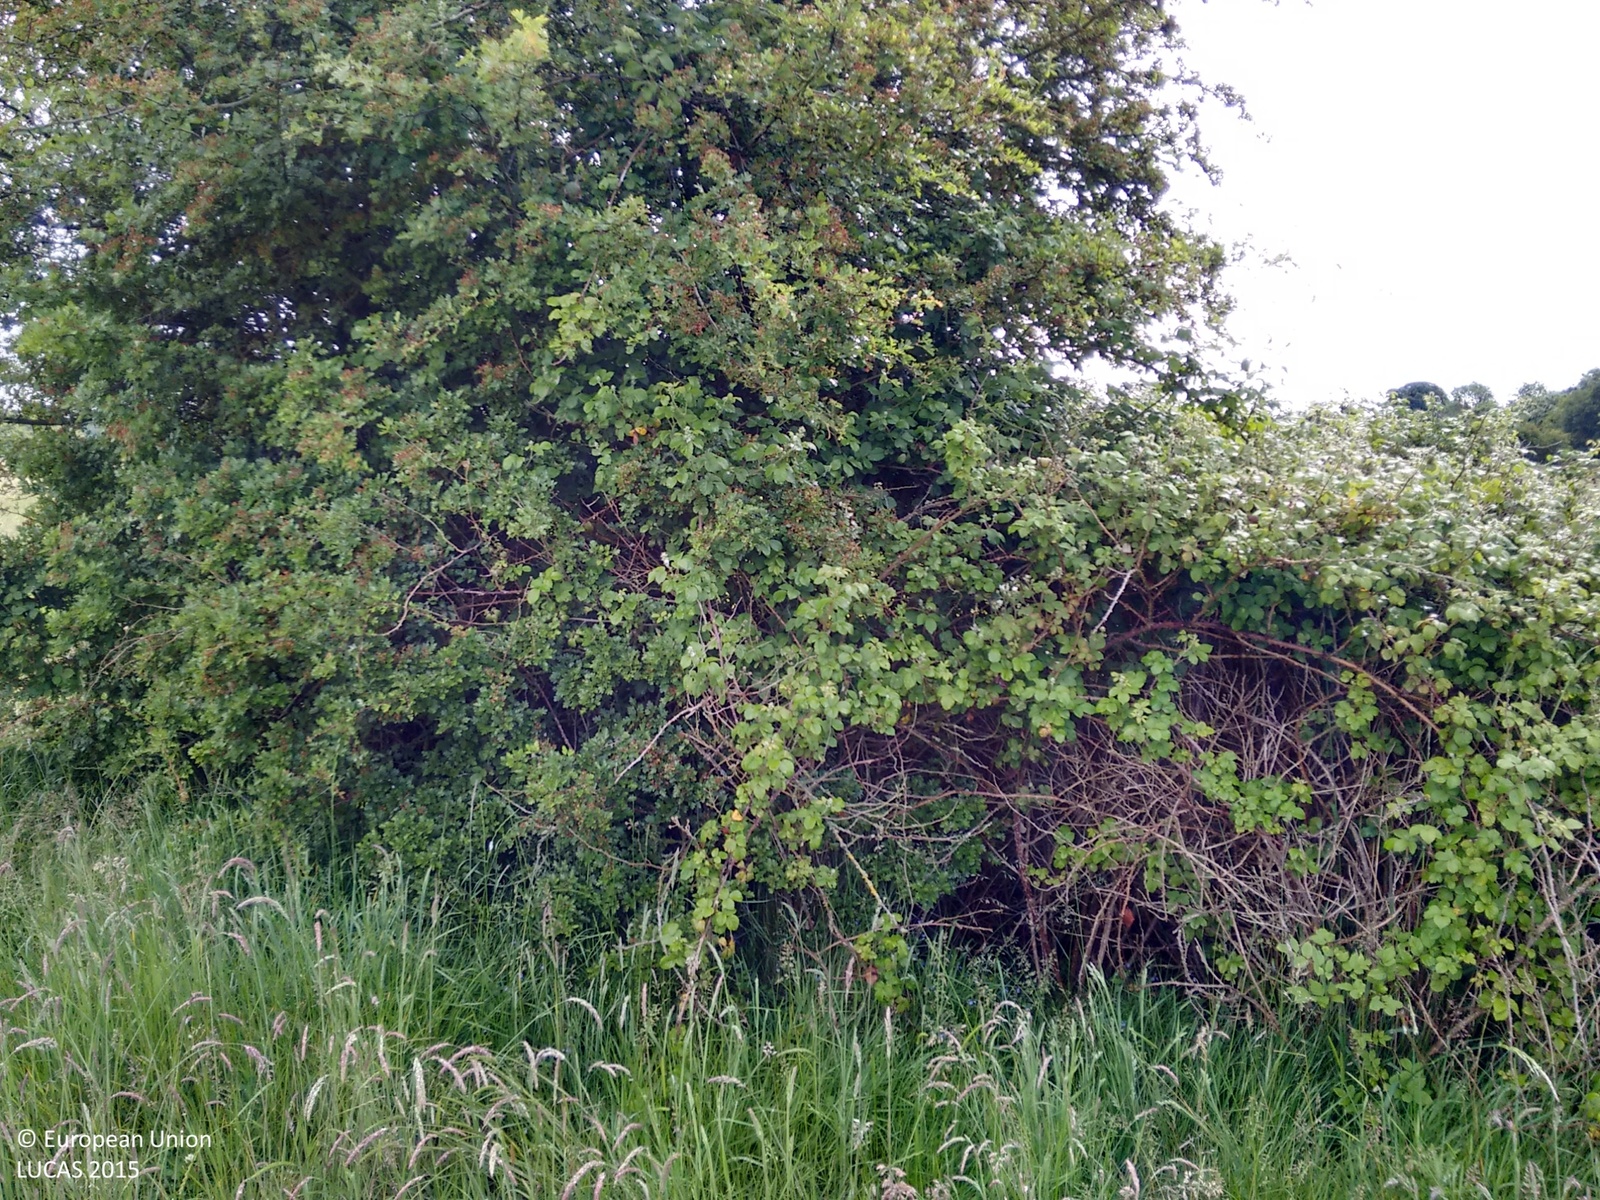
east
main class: Grassland
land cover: Grassland without tree/shrub cover
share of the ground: > 75 %
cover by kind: herbaceous plants 100 %
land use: Agriculture (excluding fallow land and kitchen gardens)
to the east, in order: Grassland without tree/shrub cover; Managed hedges; Grassland without tree/shrub cover; Managed hedges; Grassland without tree/shrub cover
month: June
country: IE
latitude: 53.6556
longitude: -6.7632
